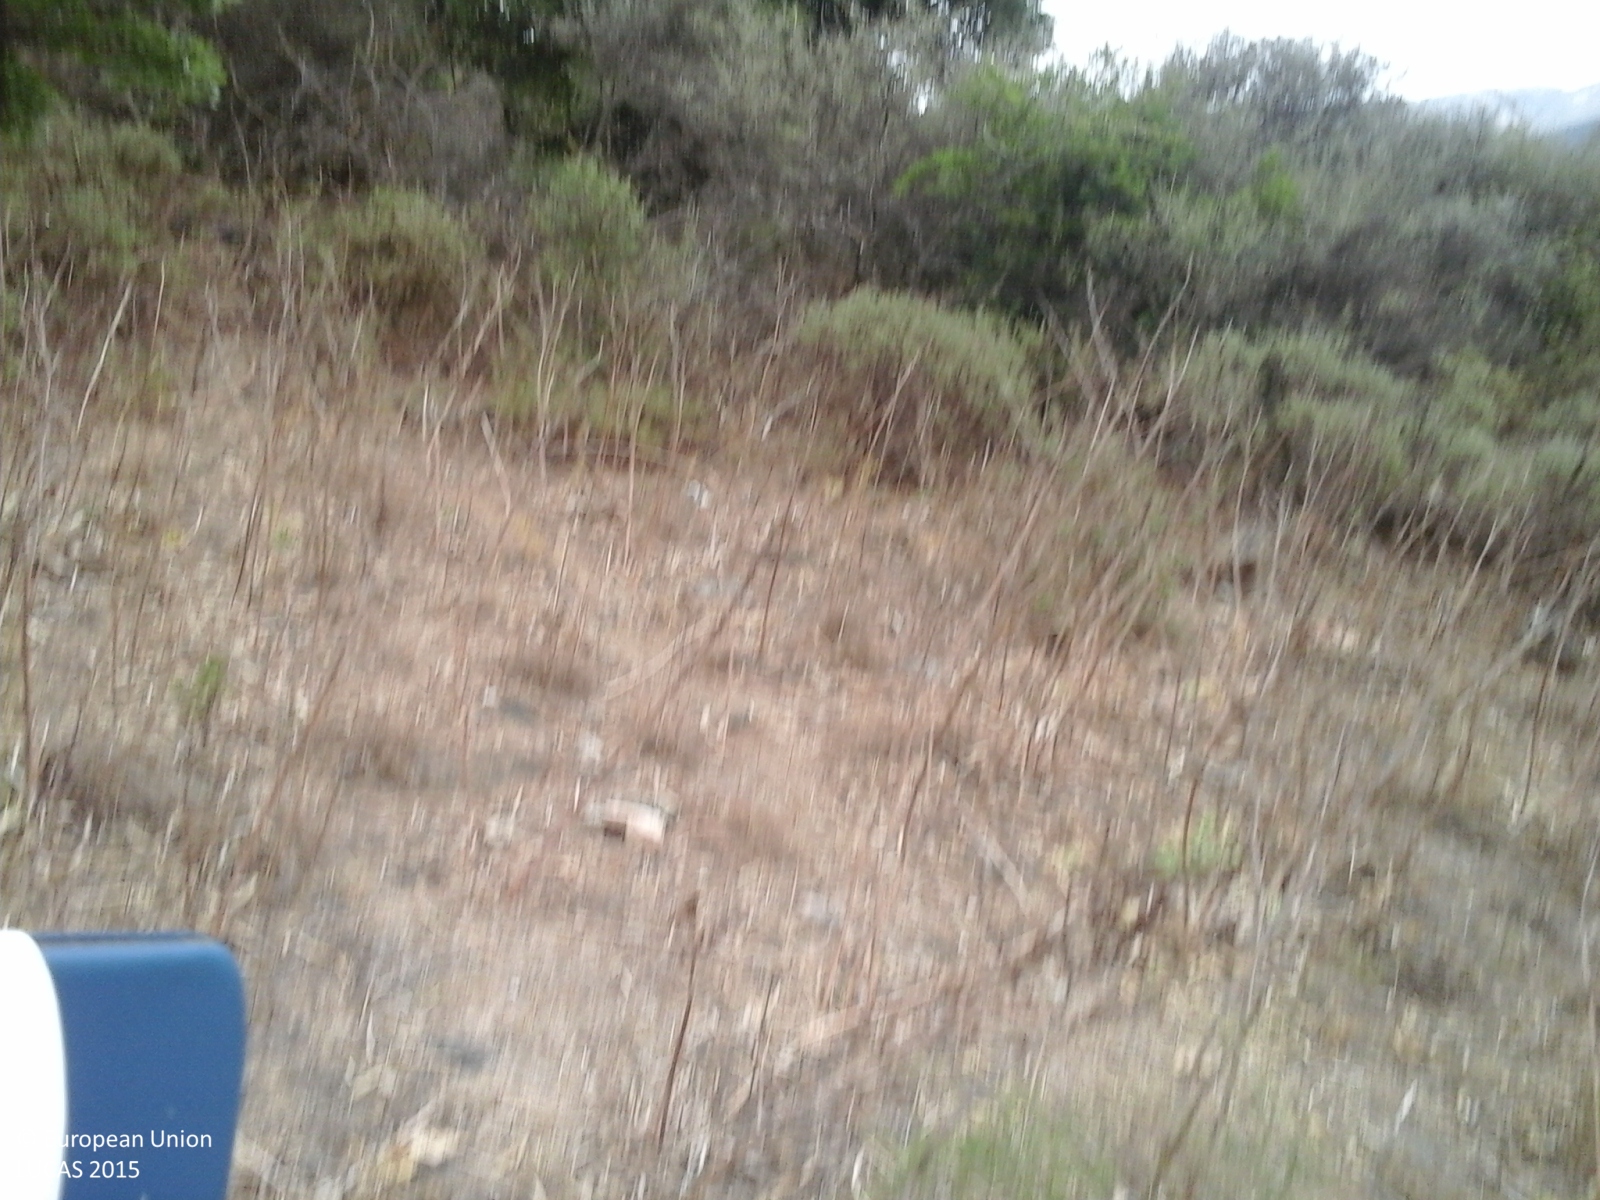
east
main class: Shrubland
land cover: Shrubland with sparse tree cover
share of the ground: > 75 %
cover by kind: shrubs 95 %, broadleaved forest trees 5 %
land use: Agriculture (excluding fallow land and kitchen gardens)
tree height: < 5 m
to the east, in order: Shrubland with sparse tree cover; Grass margins; Other structural elements; Paved roads, cycling and walking lanes; Grass margins; Broadleaved woodland; Abandoned hedges; Tracks; Grassland with sparse tree/shrub cover; Fences; Broadleaved woodland; Grassland without tree/shrub cover
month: August
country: IT
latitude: 39.9733
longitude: 9.0801
